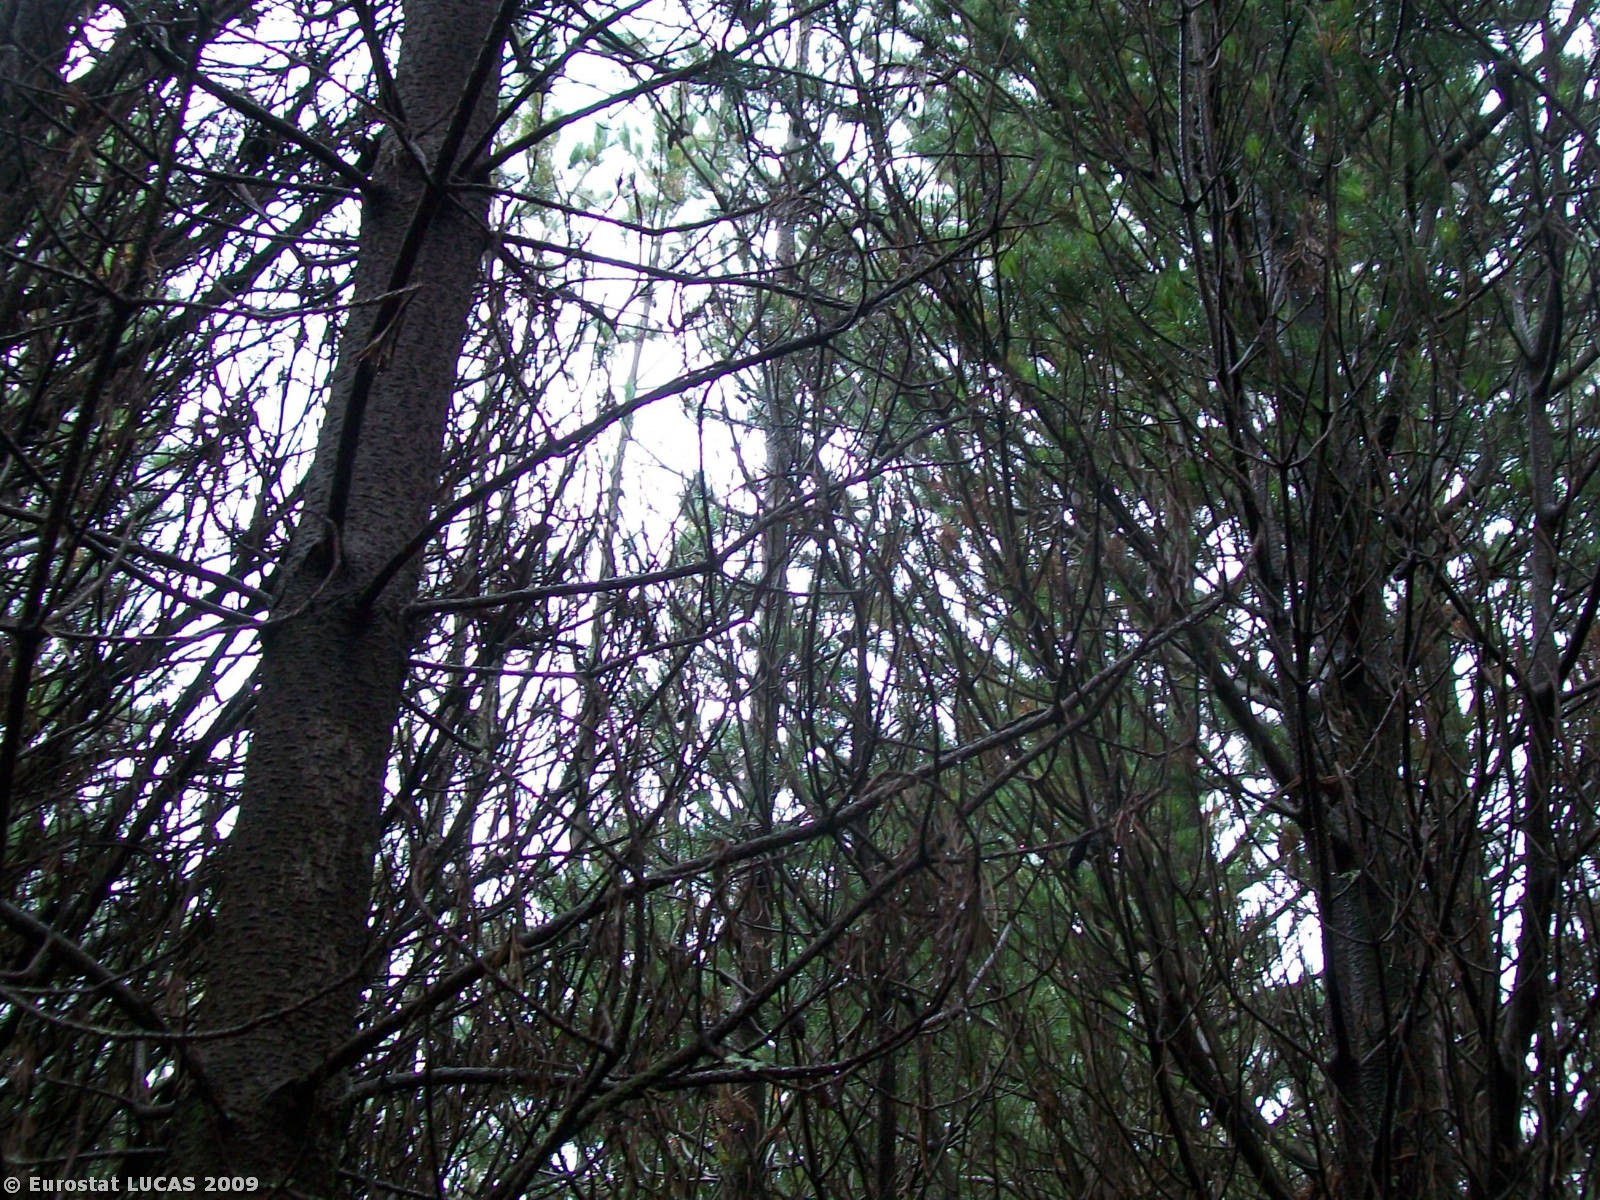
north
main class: Woodland
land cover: Coniferous woodland
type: plantations and self-sown exotic forest
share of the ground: > 75 %
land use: Forestry
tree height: > 5 m
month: August
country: GB
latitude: 58.6245
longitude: -3.1973
